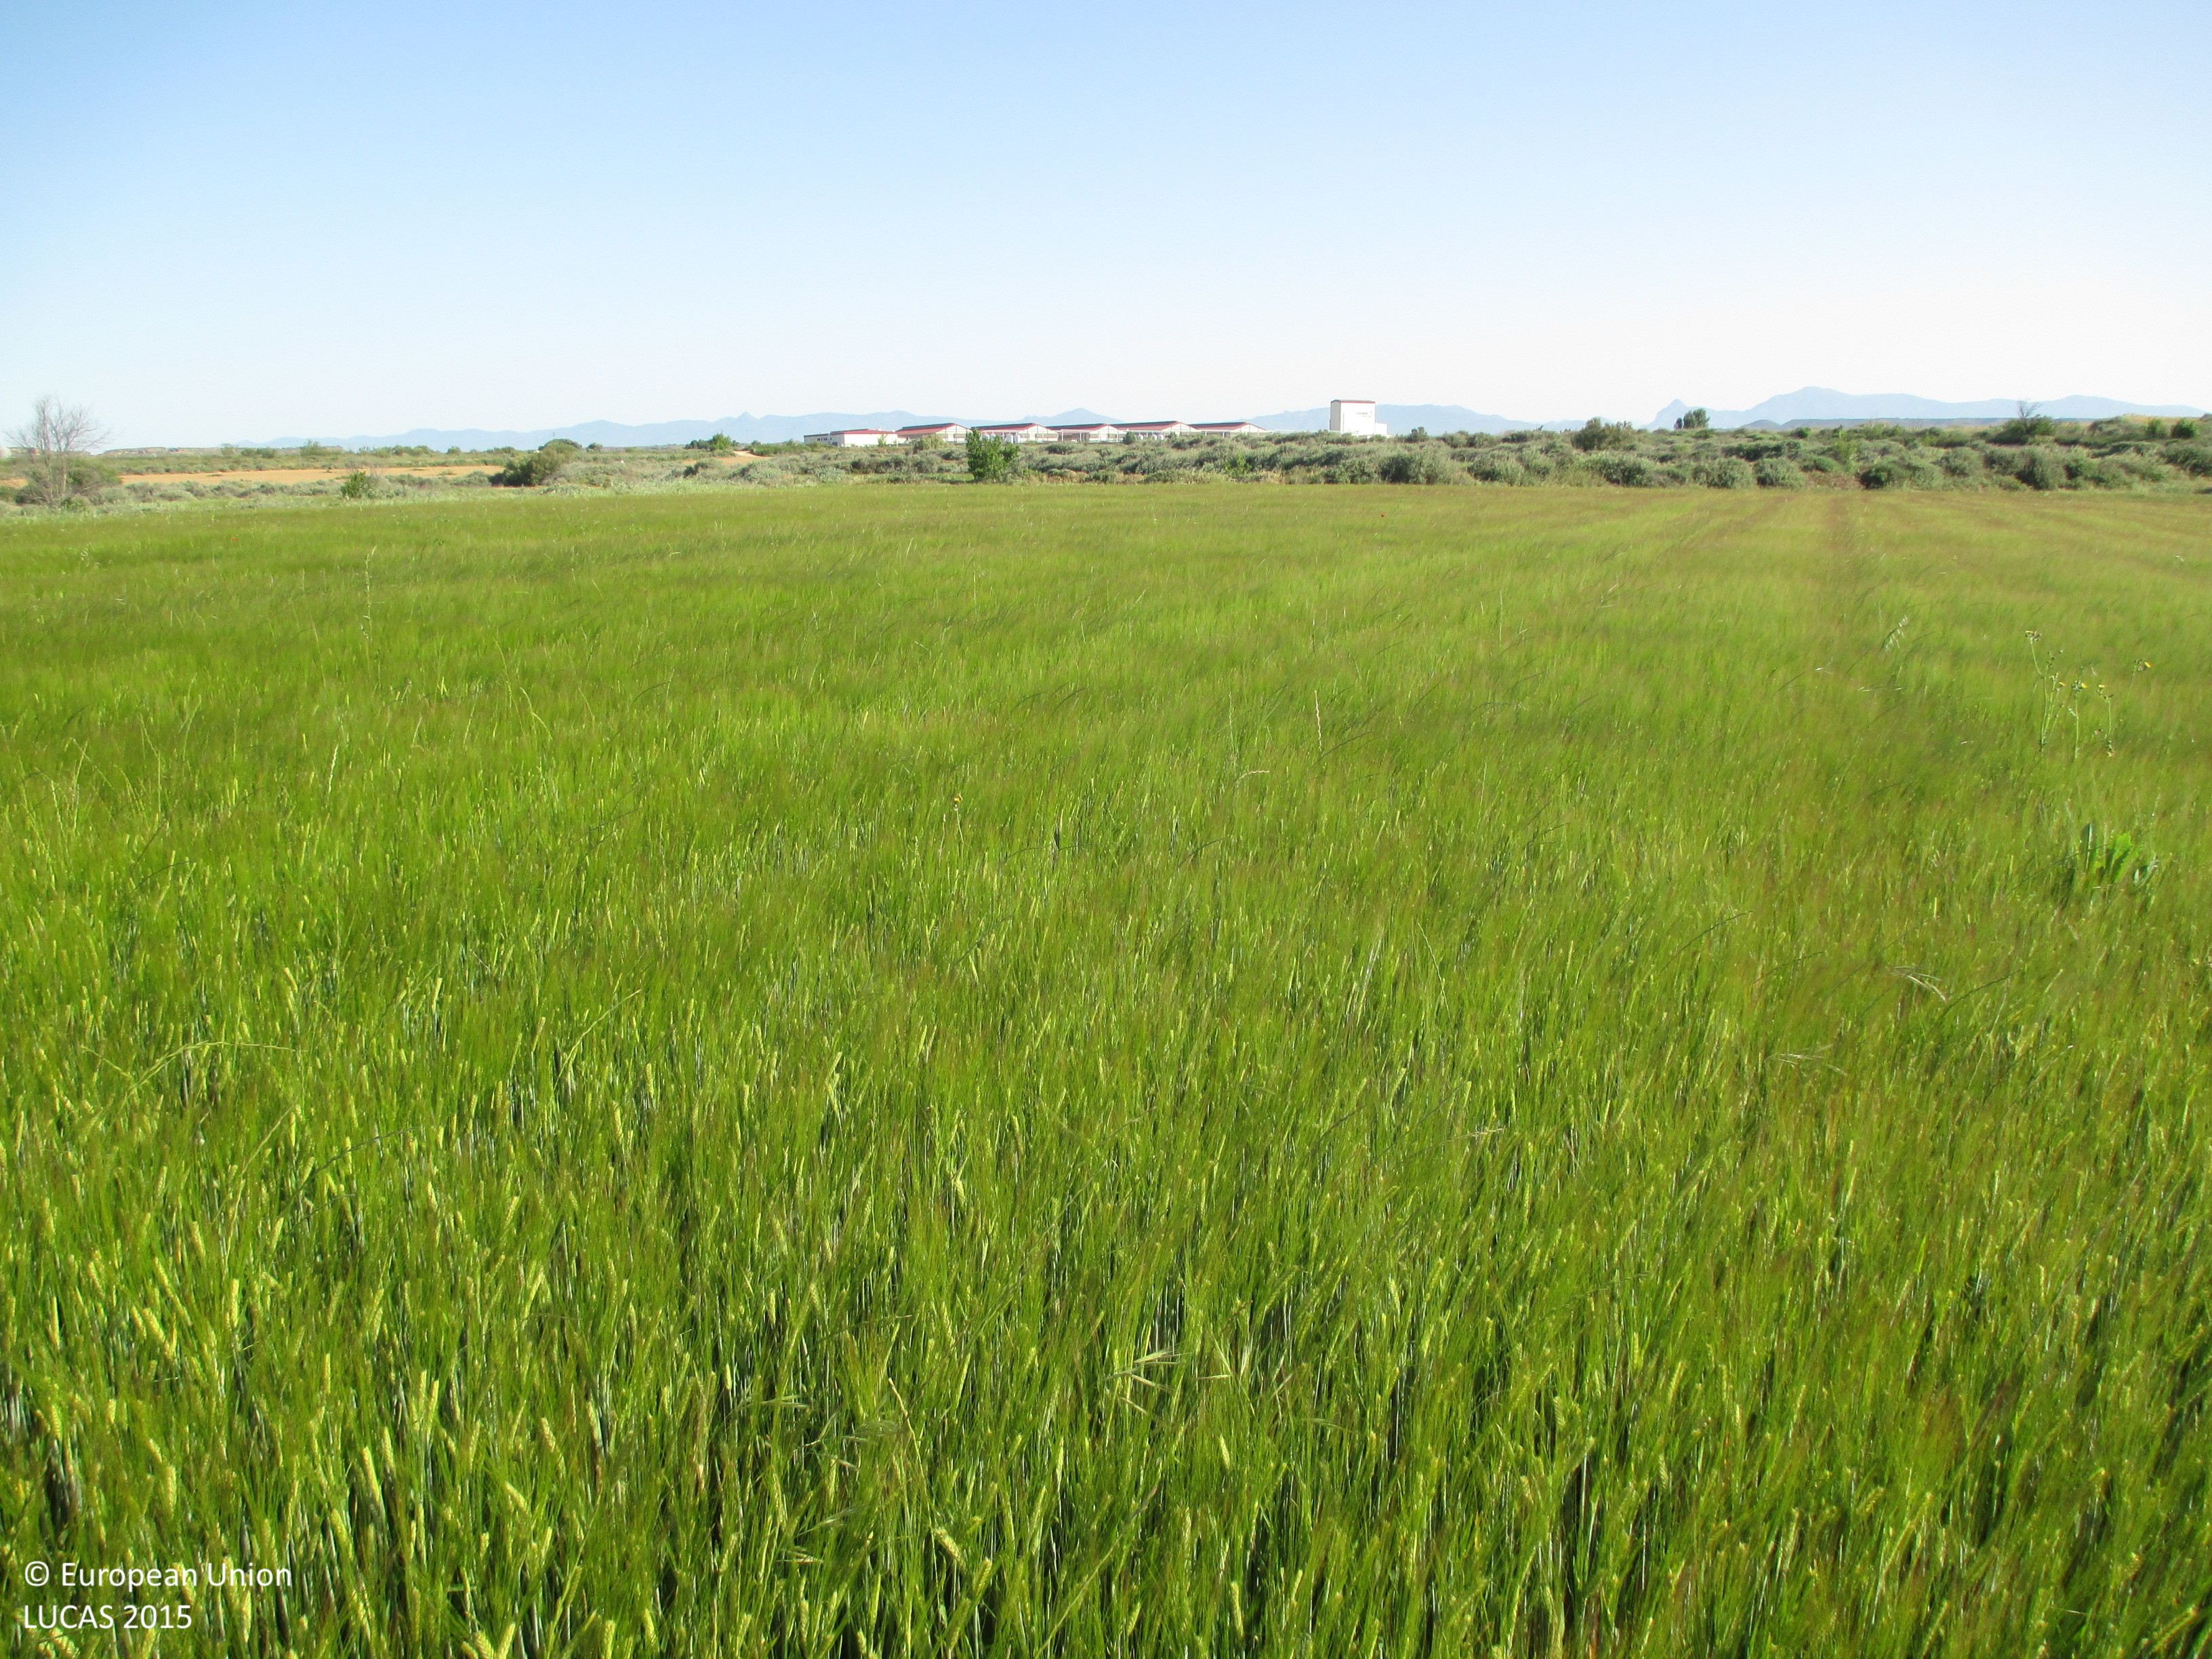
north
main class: Cropland
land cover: Barley
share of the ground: > 75 %
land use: Agriculture (excluding fallow land and kitchen gardens)
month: May
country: ES
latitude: 41.9576
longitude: -0.3602
